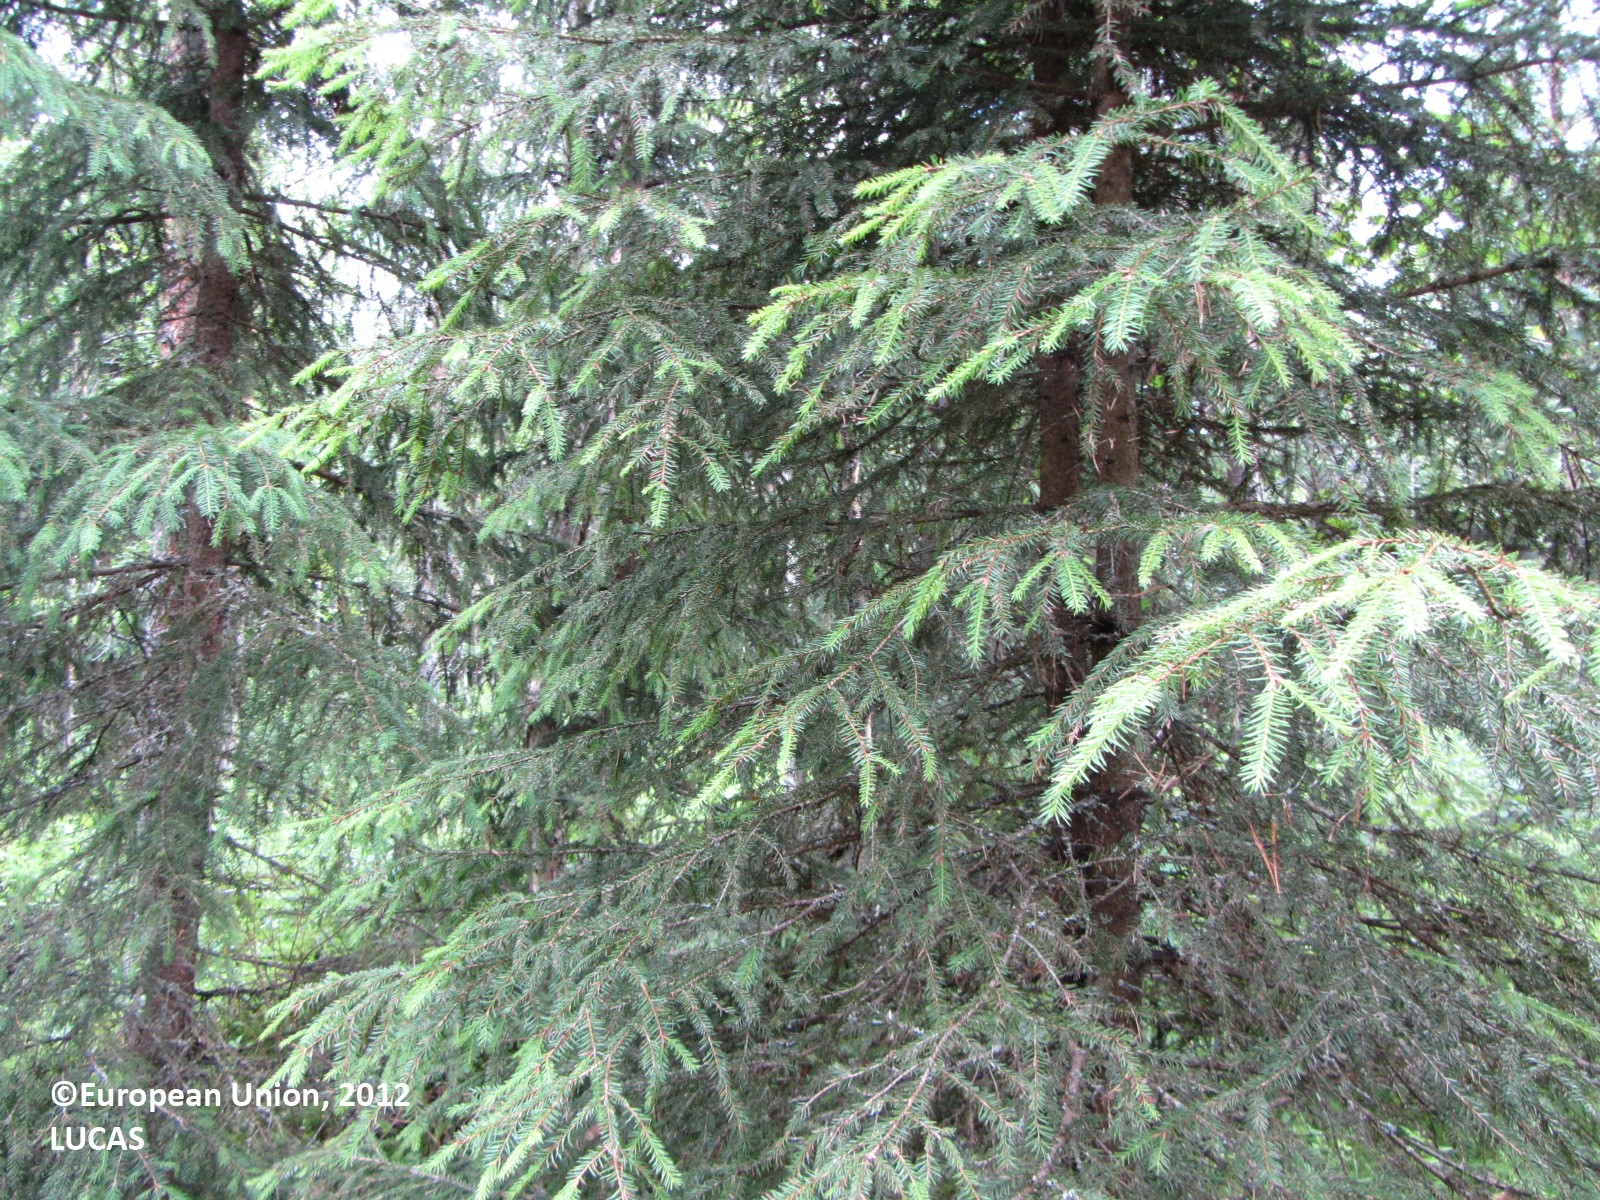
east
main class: Woodland
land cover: Other mixed woodland
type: boreal forest
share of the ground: 50 - 75 %
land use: Forestry
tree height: > 5 m
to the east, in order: Other mixed woodland; Shrubland with sparse tree cover; Other mixed woodland; Ditches and canals; Pine dominated mixed woodland; Shrubland with sparse tree cover; Pine dominated mixed woodland; Tracks; Pine dominated coniferous woodland; Tracks; Pine dominated mixed woodland; Ditches and canals; Pine dominated mixed woodland; Ditches and canals; Pine dominated mixed woodland; Shrubland with sparse tree cover; Other mixed woodland
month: July
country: FI
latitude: 63.6244
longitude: 25.3699
